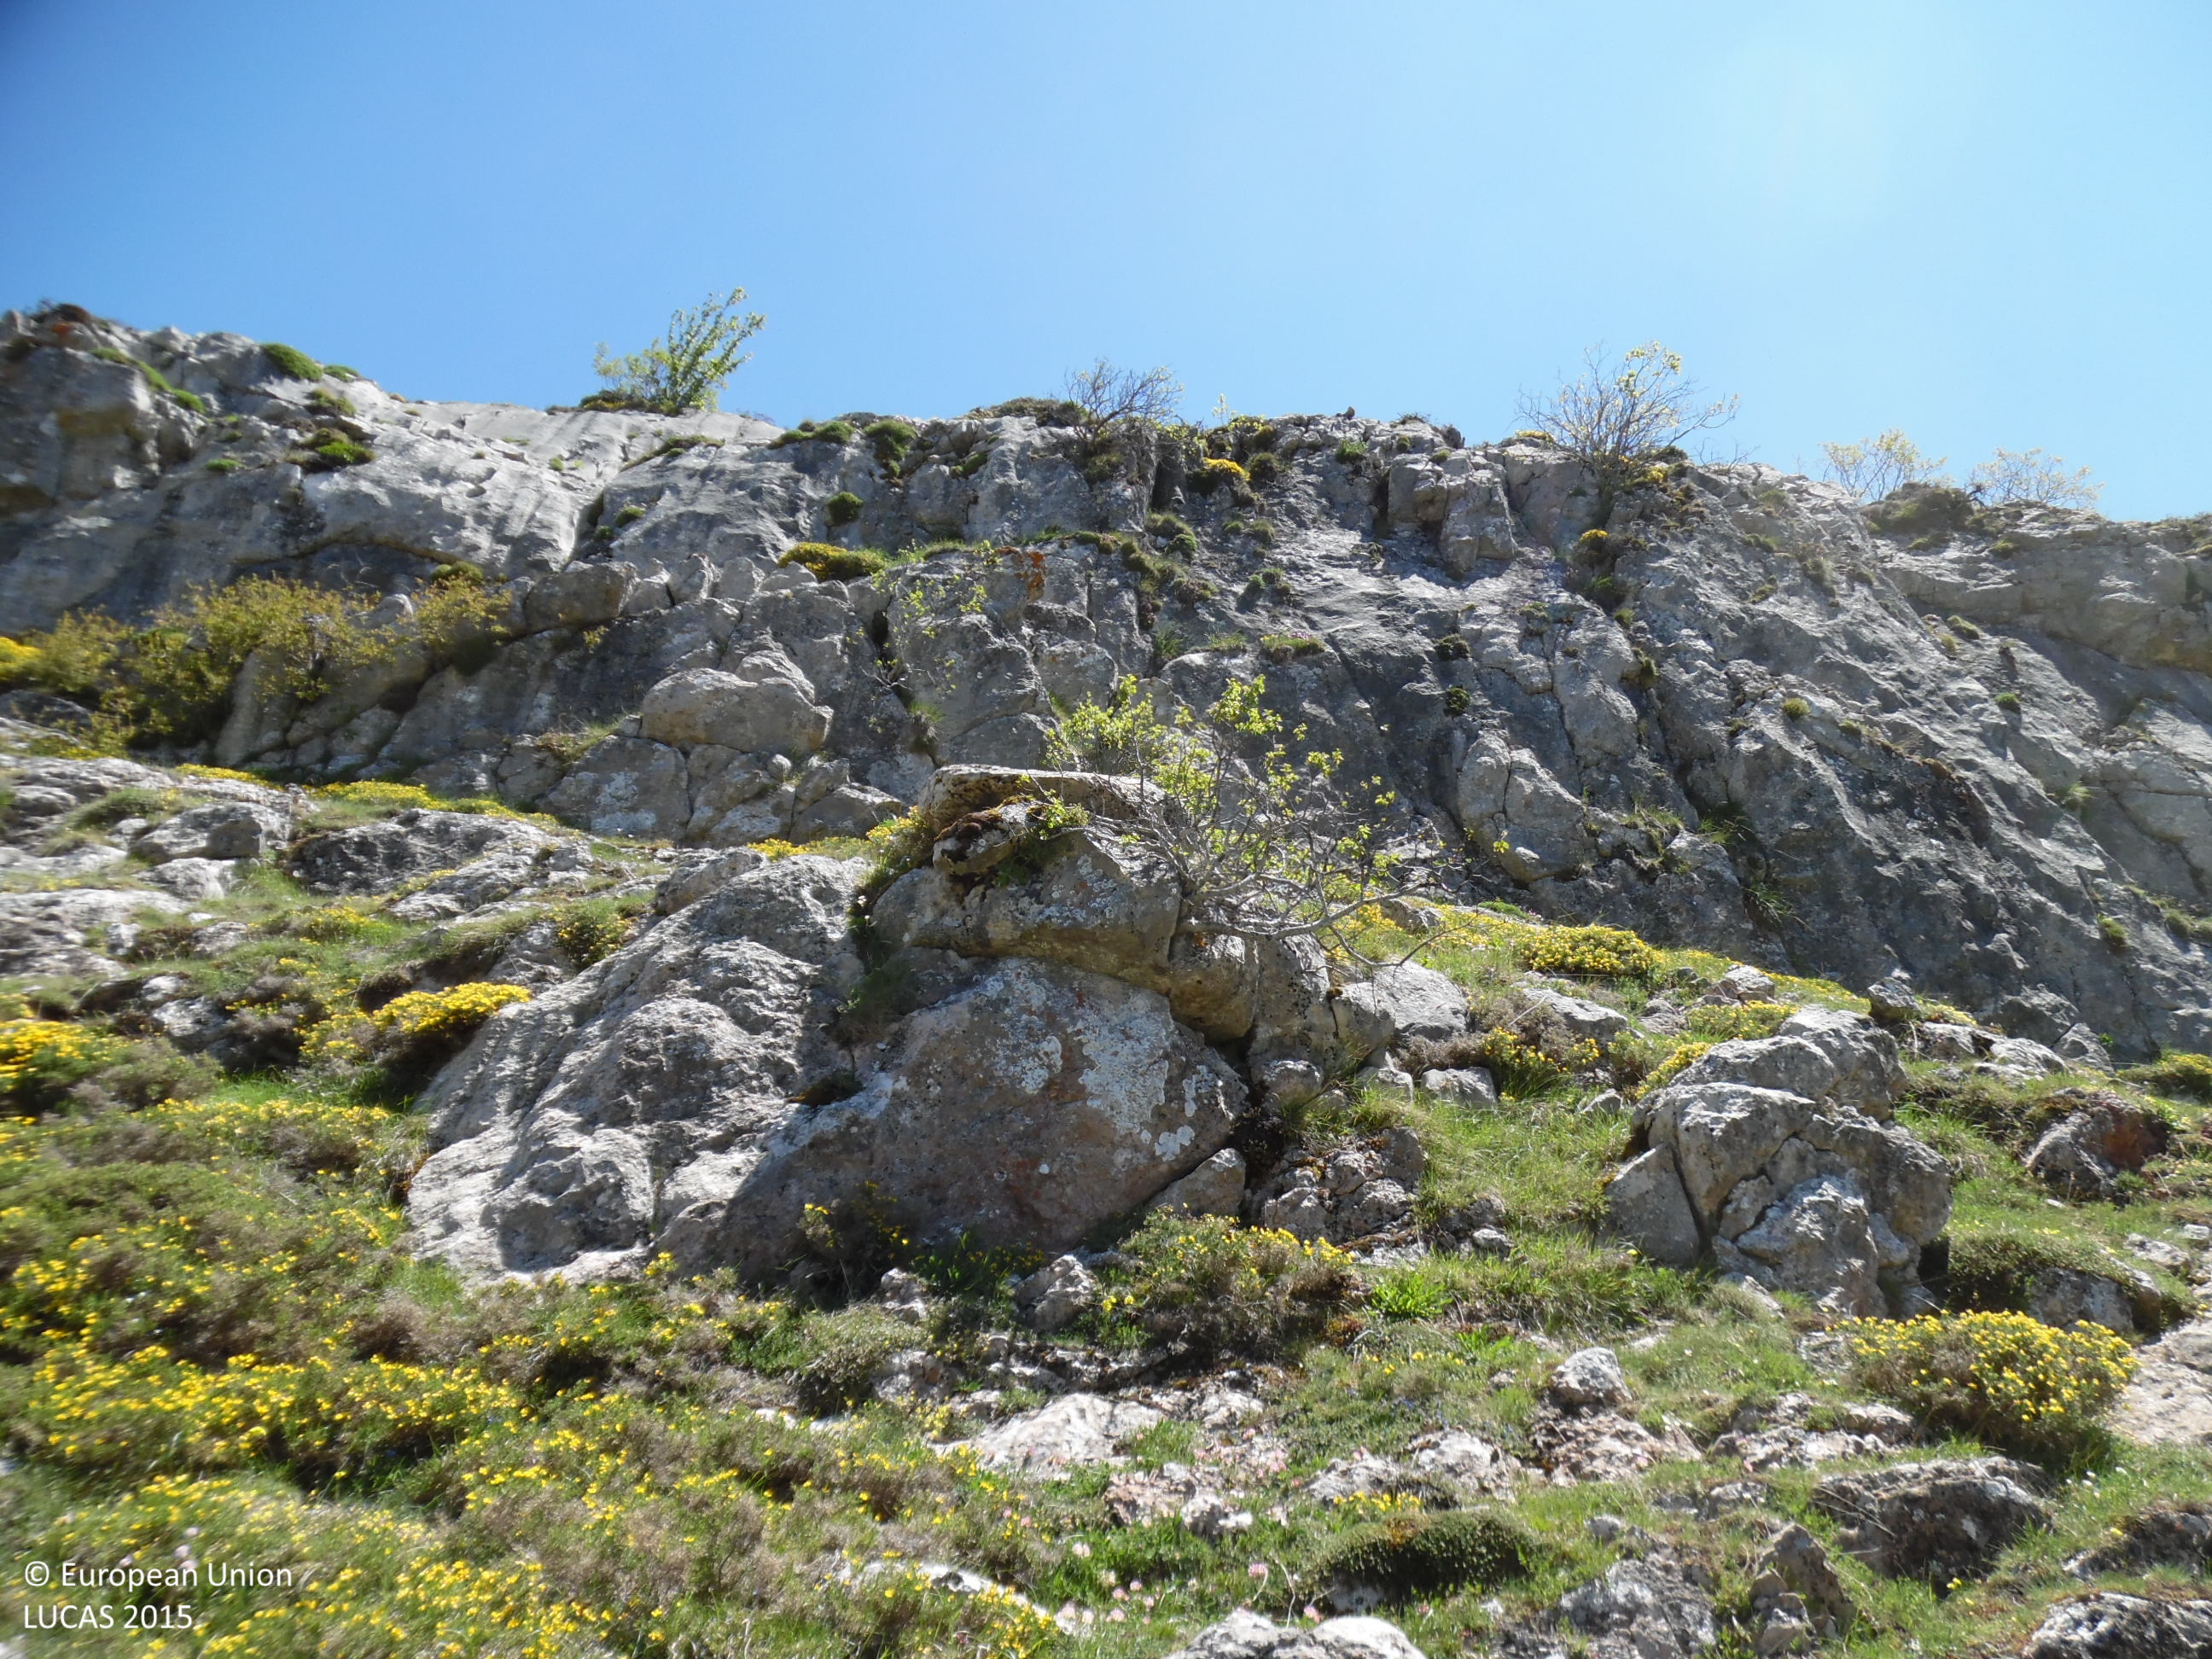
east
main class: Grassland
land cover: Grassland without tree/shrub cover
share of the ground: 50 - 75 %
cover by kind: herbaceous plants 95 %, consolidated bare surface 5 %
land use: Agriculture (excluding fallow land and kitchen gardens)
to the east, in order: Grassland without tree/shrub cover; Rocks and stones; Shrubland without tree cover; Rocks and stones; Shrubland without tree cover; Grassland without tree/shrub cover; Rocks and stones; Grassland without tree/shrub cover; Shrubland without tree cover; Grassland with sparse tree/shrub cover
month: May
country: ES
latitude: 43.0082
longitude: -6.2251
